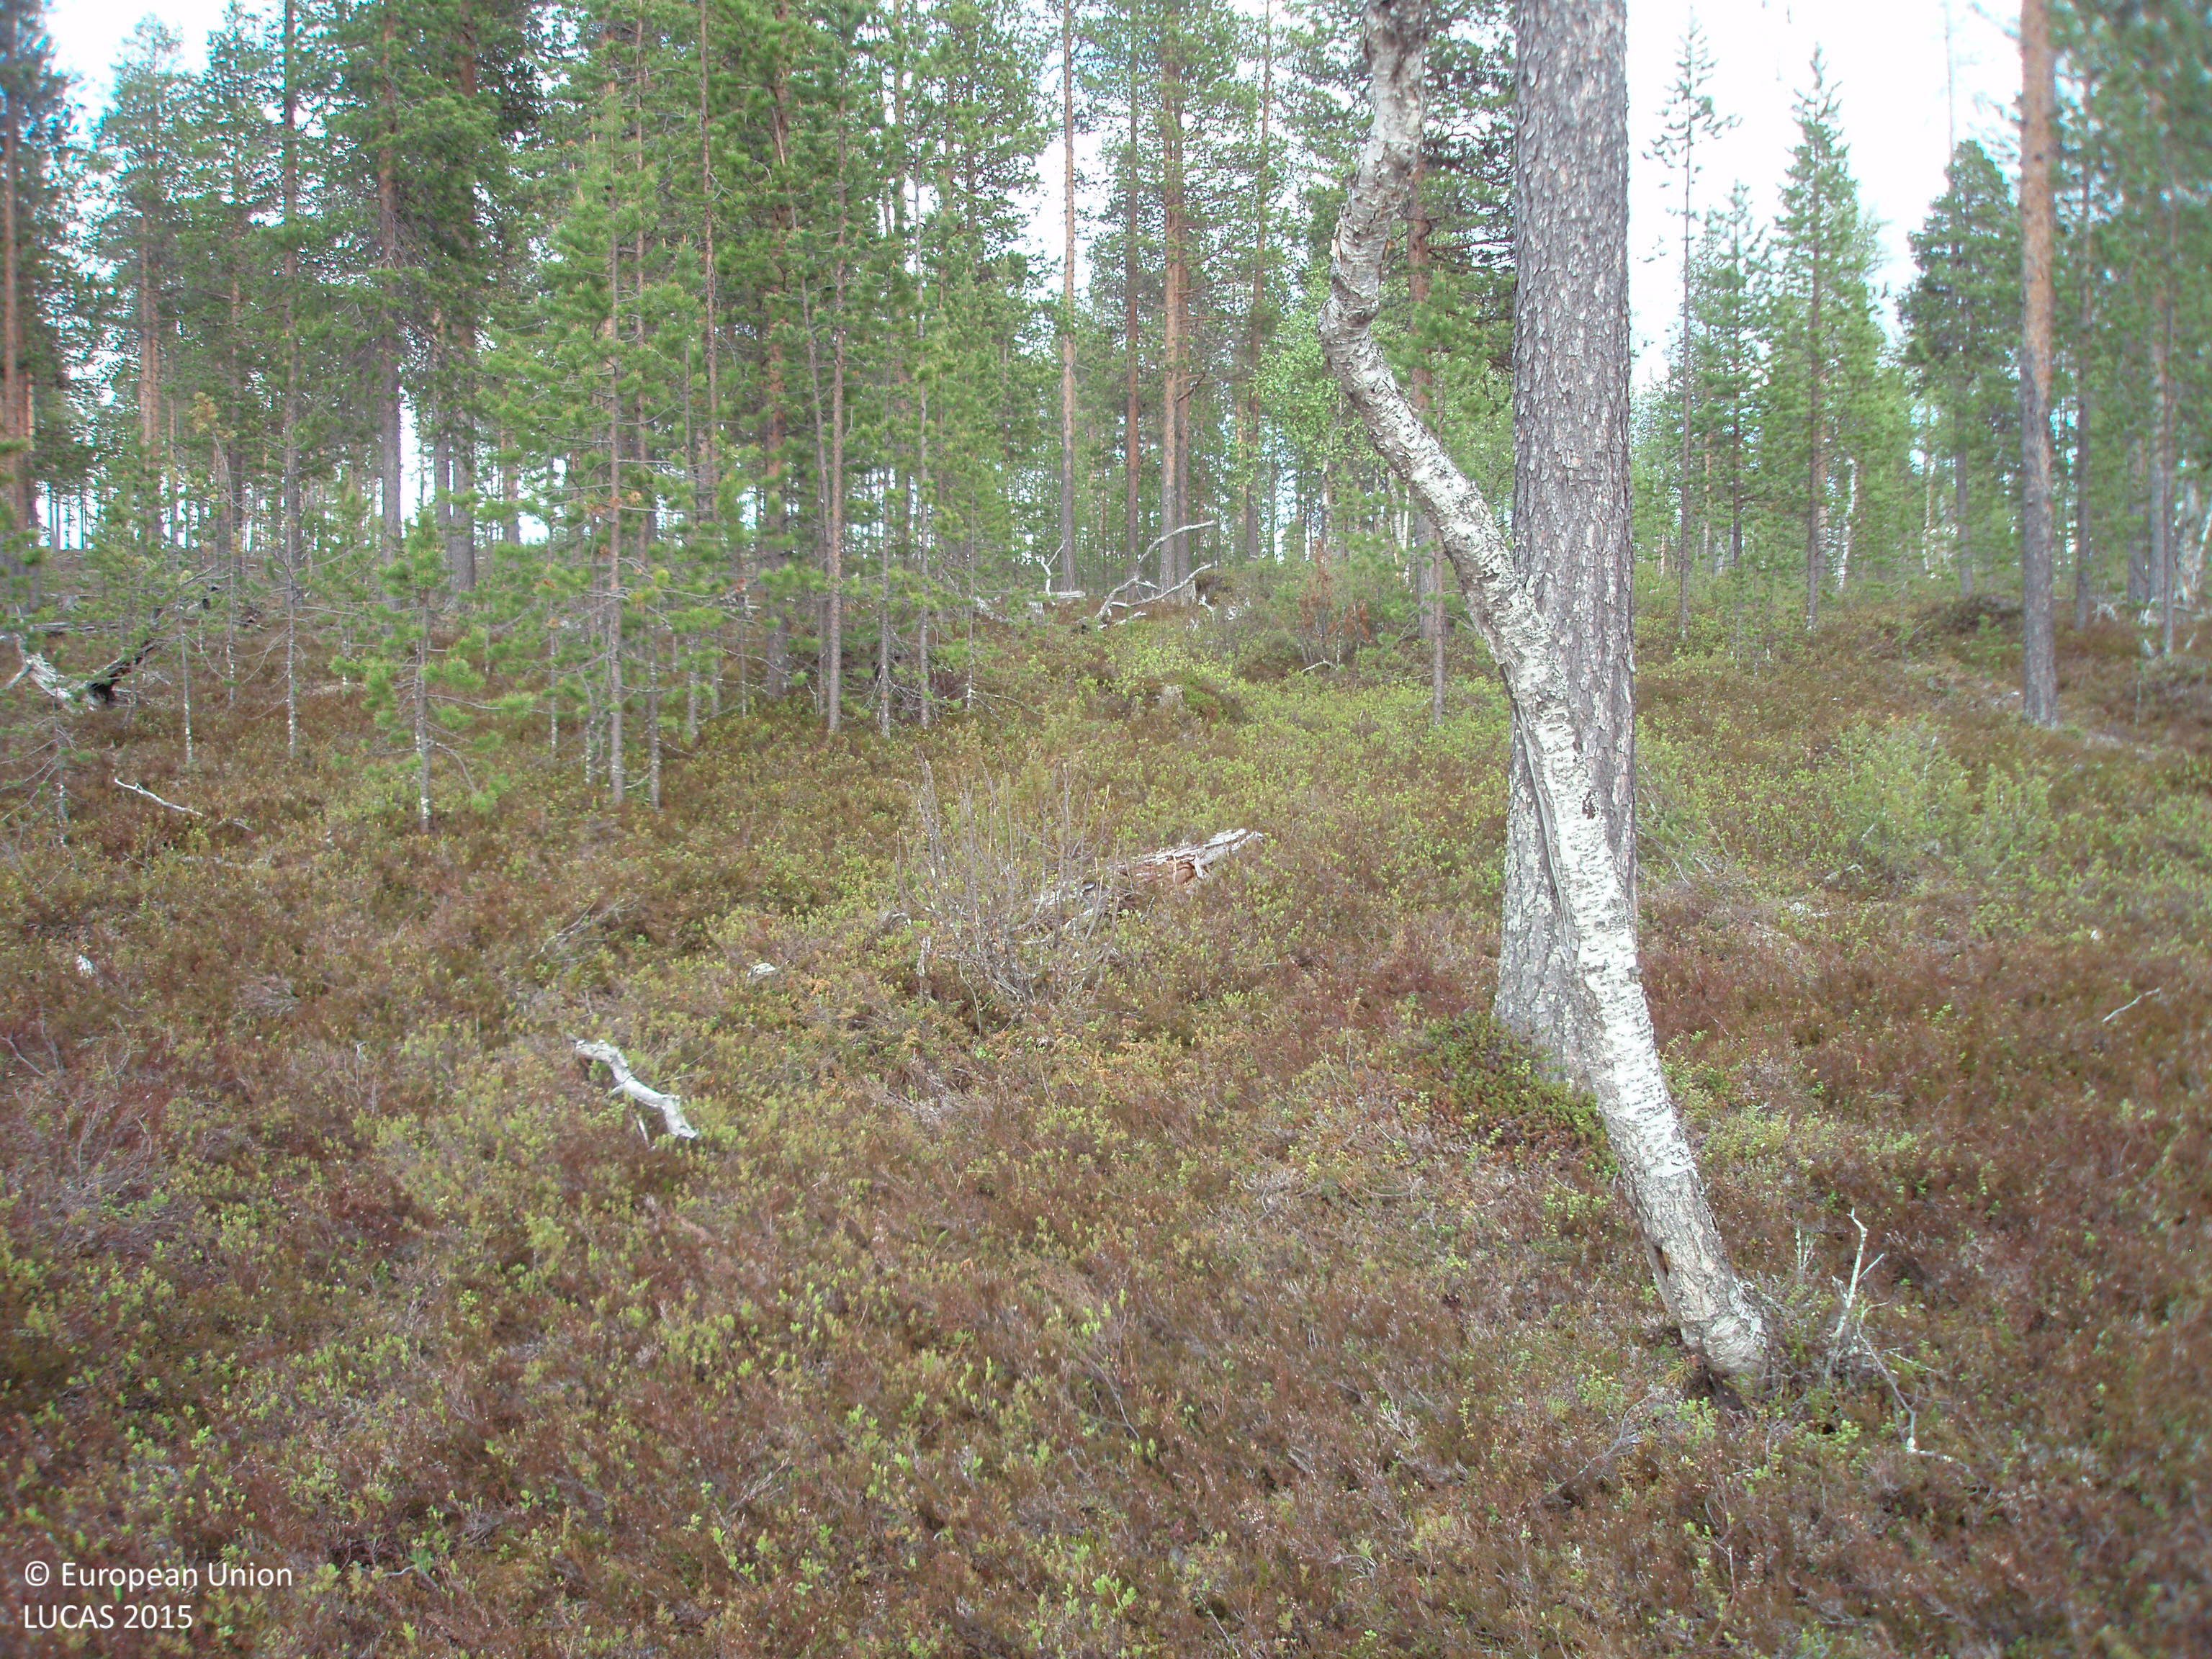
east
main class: Woodland
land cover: Pine dominated coniferous woodland
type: boreal forest
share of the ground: 25 - 50 %
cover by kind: shrubs 70 %, coniferous forest trees 25 %, lichens and mosses 5 %
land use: Forestry
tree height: > 5 m
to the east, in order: Pine dominated coniferous woodland; Tracks; Pine dominated coniferous woodland; Shrubland with sparse tree cover
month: June
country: FI
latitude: 68.4356
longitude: 27.8644
